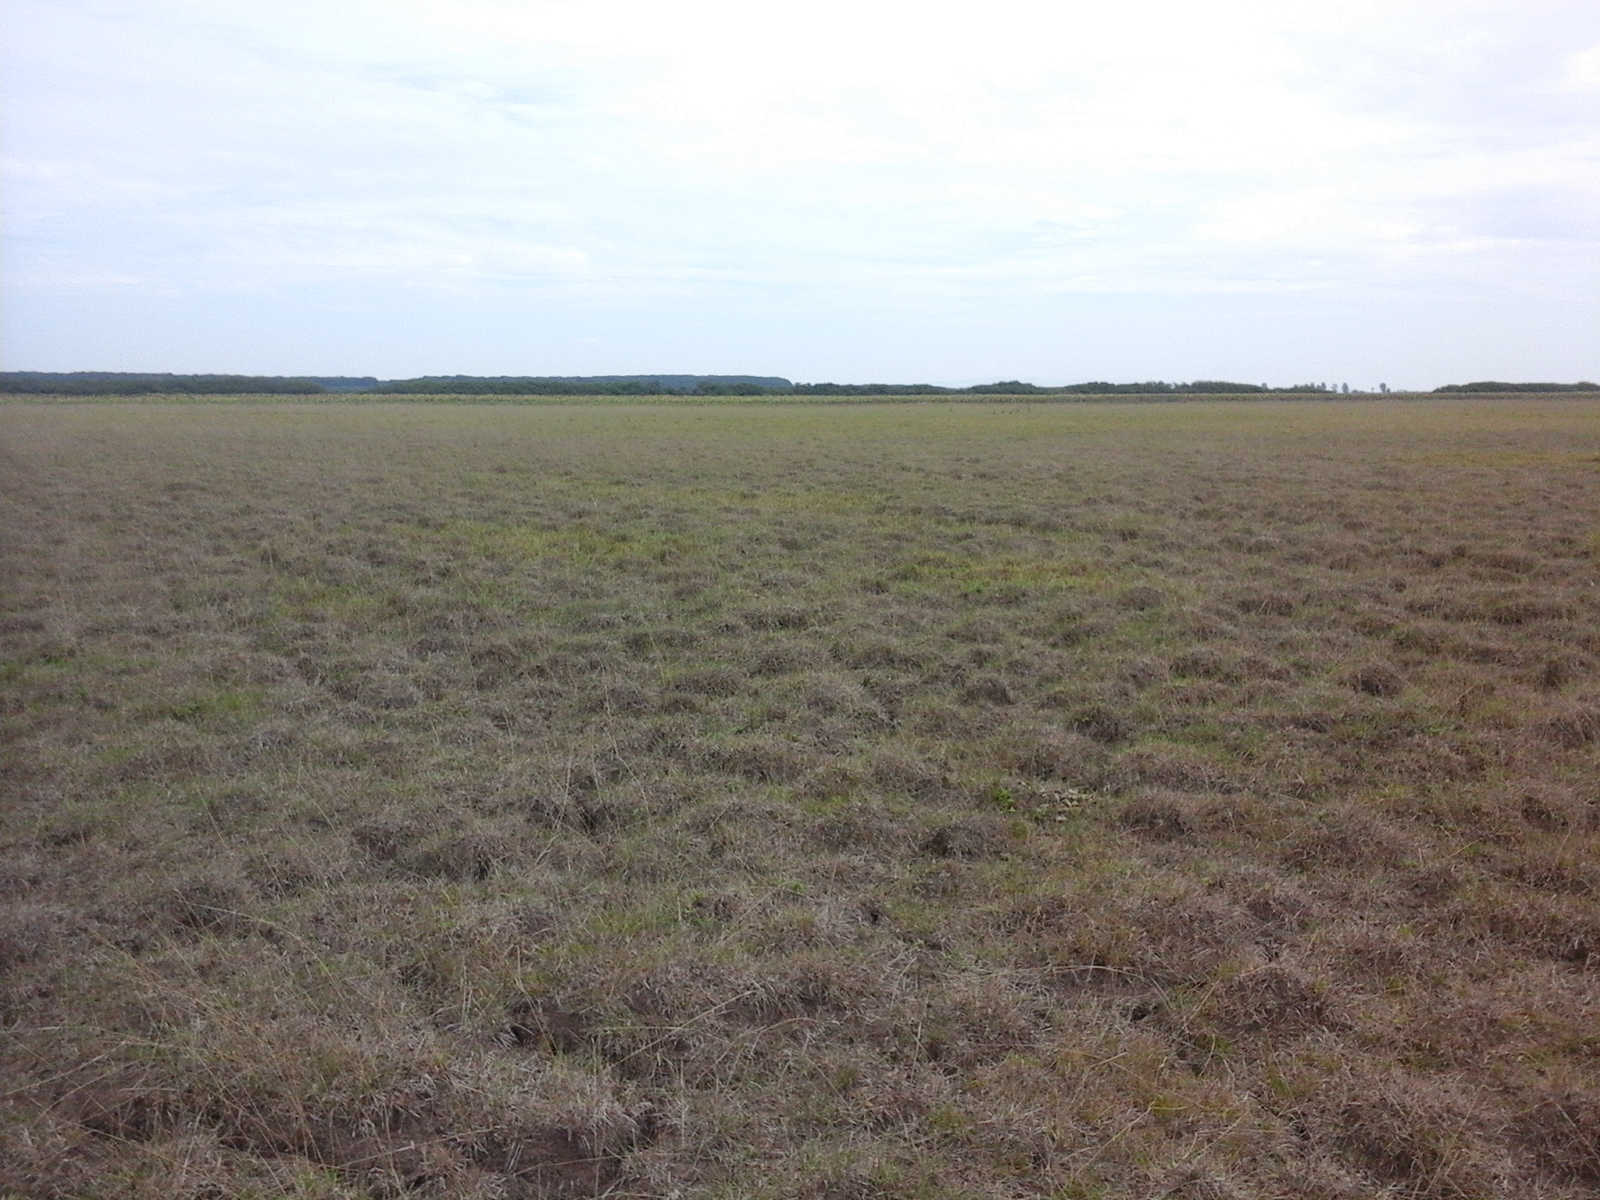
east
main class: Grassland
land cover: Grassland without tree/shrub cover
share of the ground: > 75 %
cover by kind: herbaceous plants 100 %
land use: Agriculture (excluding fallow land and kitchen gardens)
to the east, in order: Grassland without tree/shrub cover
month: August
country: RO
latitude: 46.5374
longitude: 21.4202
